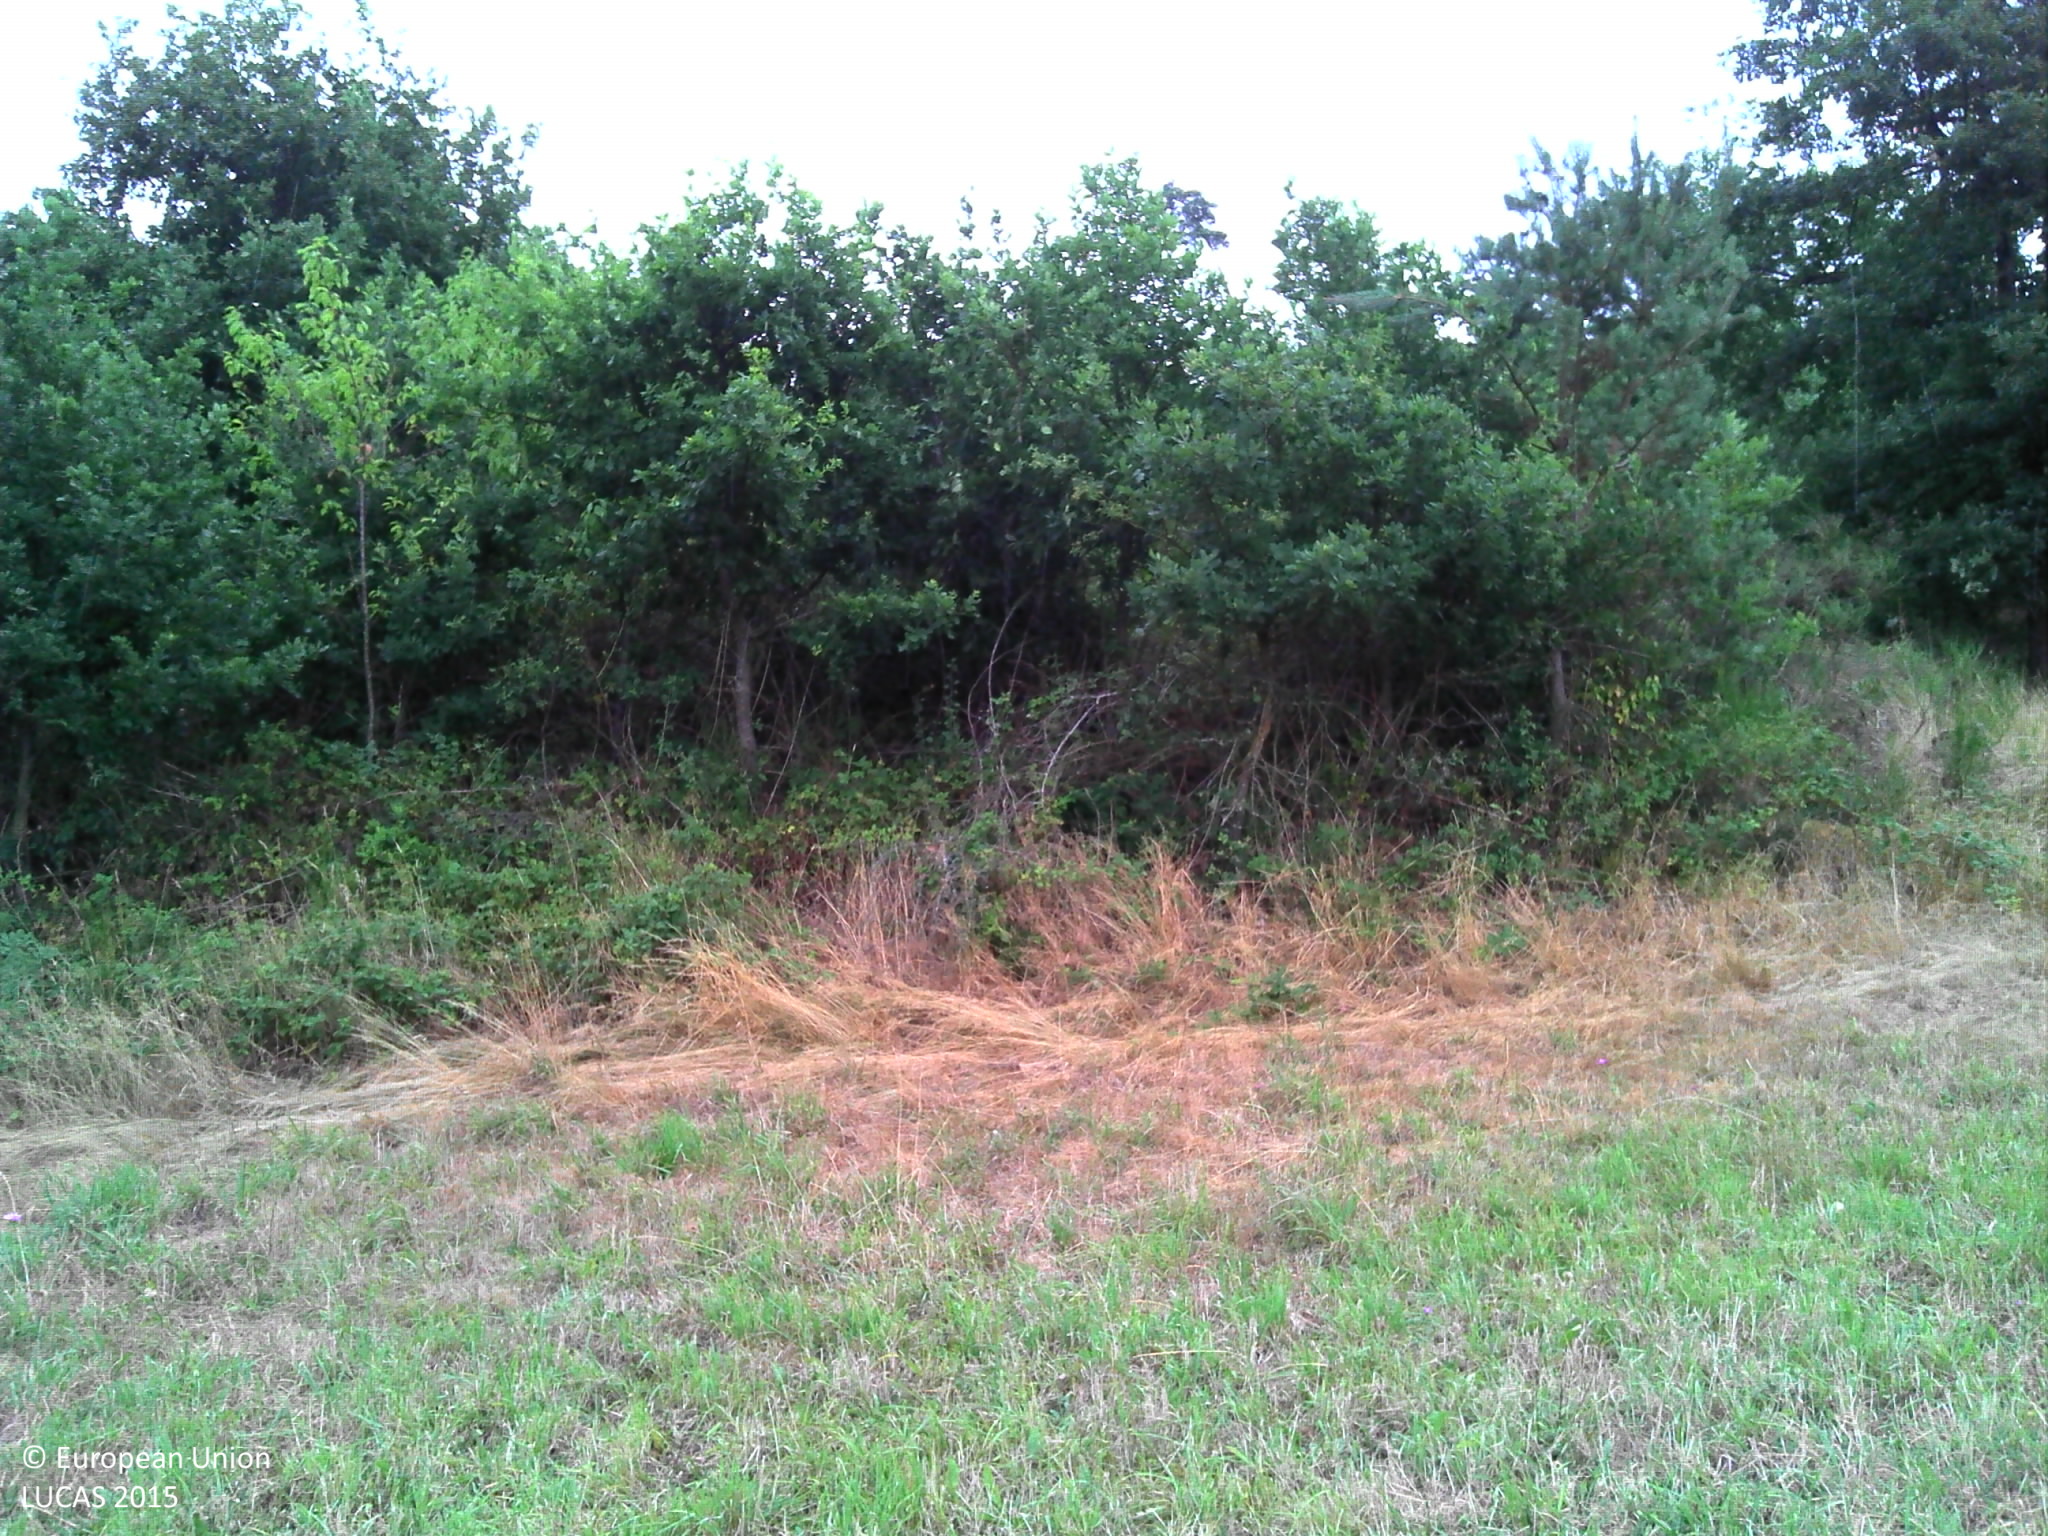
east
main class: Grassland
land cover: Grassland without tree/shrub cover
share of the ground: > 75 %
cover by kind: herbaceous plants 90 %, lichens and mosses 5 %, unconsolidated bare surface 5 %
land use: Agriculture (excluding fallow land and kitchen gardens)
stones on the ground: < 10 %
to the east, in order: Grassland without tree/shrub cover; Fences; Broadleaved woodland; Tracks; Broadleaved woodland; Fences; Grassland without tree/shrub cover
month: July
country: FR
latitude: 45.4318
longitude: 4.1364
